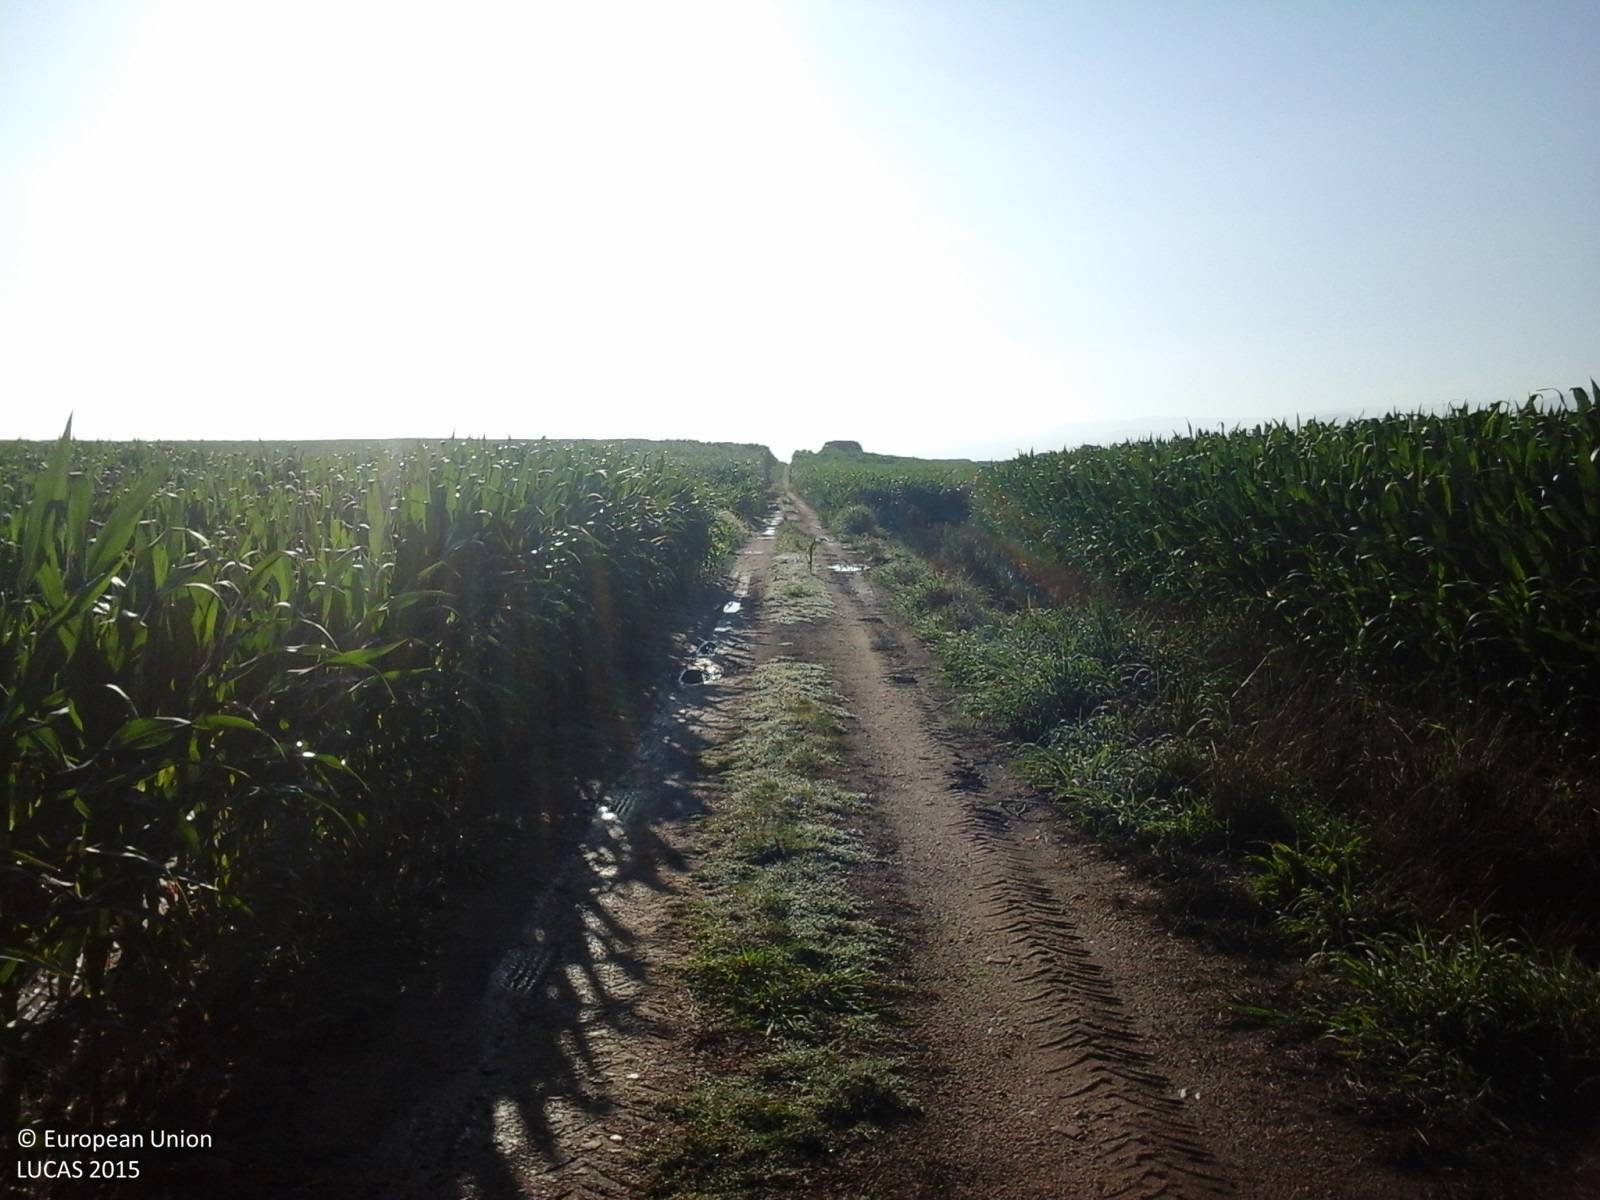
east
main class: Cropland
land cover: Maize
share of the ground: > 75 %
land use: Agriculture (excluding fallow land and kitchen gardens)
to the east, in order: Maize
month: July
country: IT
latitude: 40.6227
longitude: 8.8590
